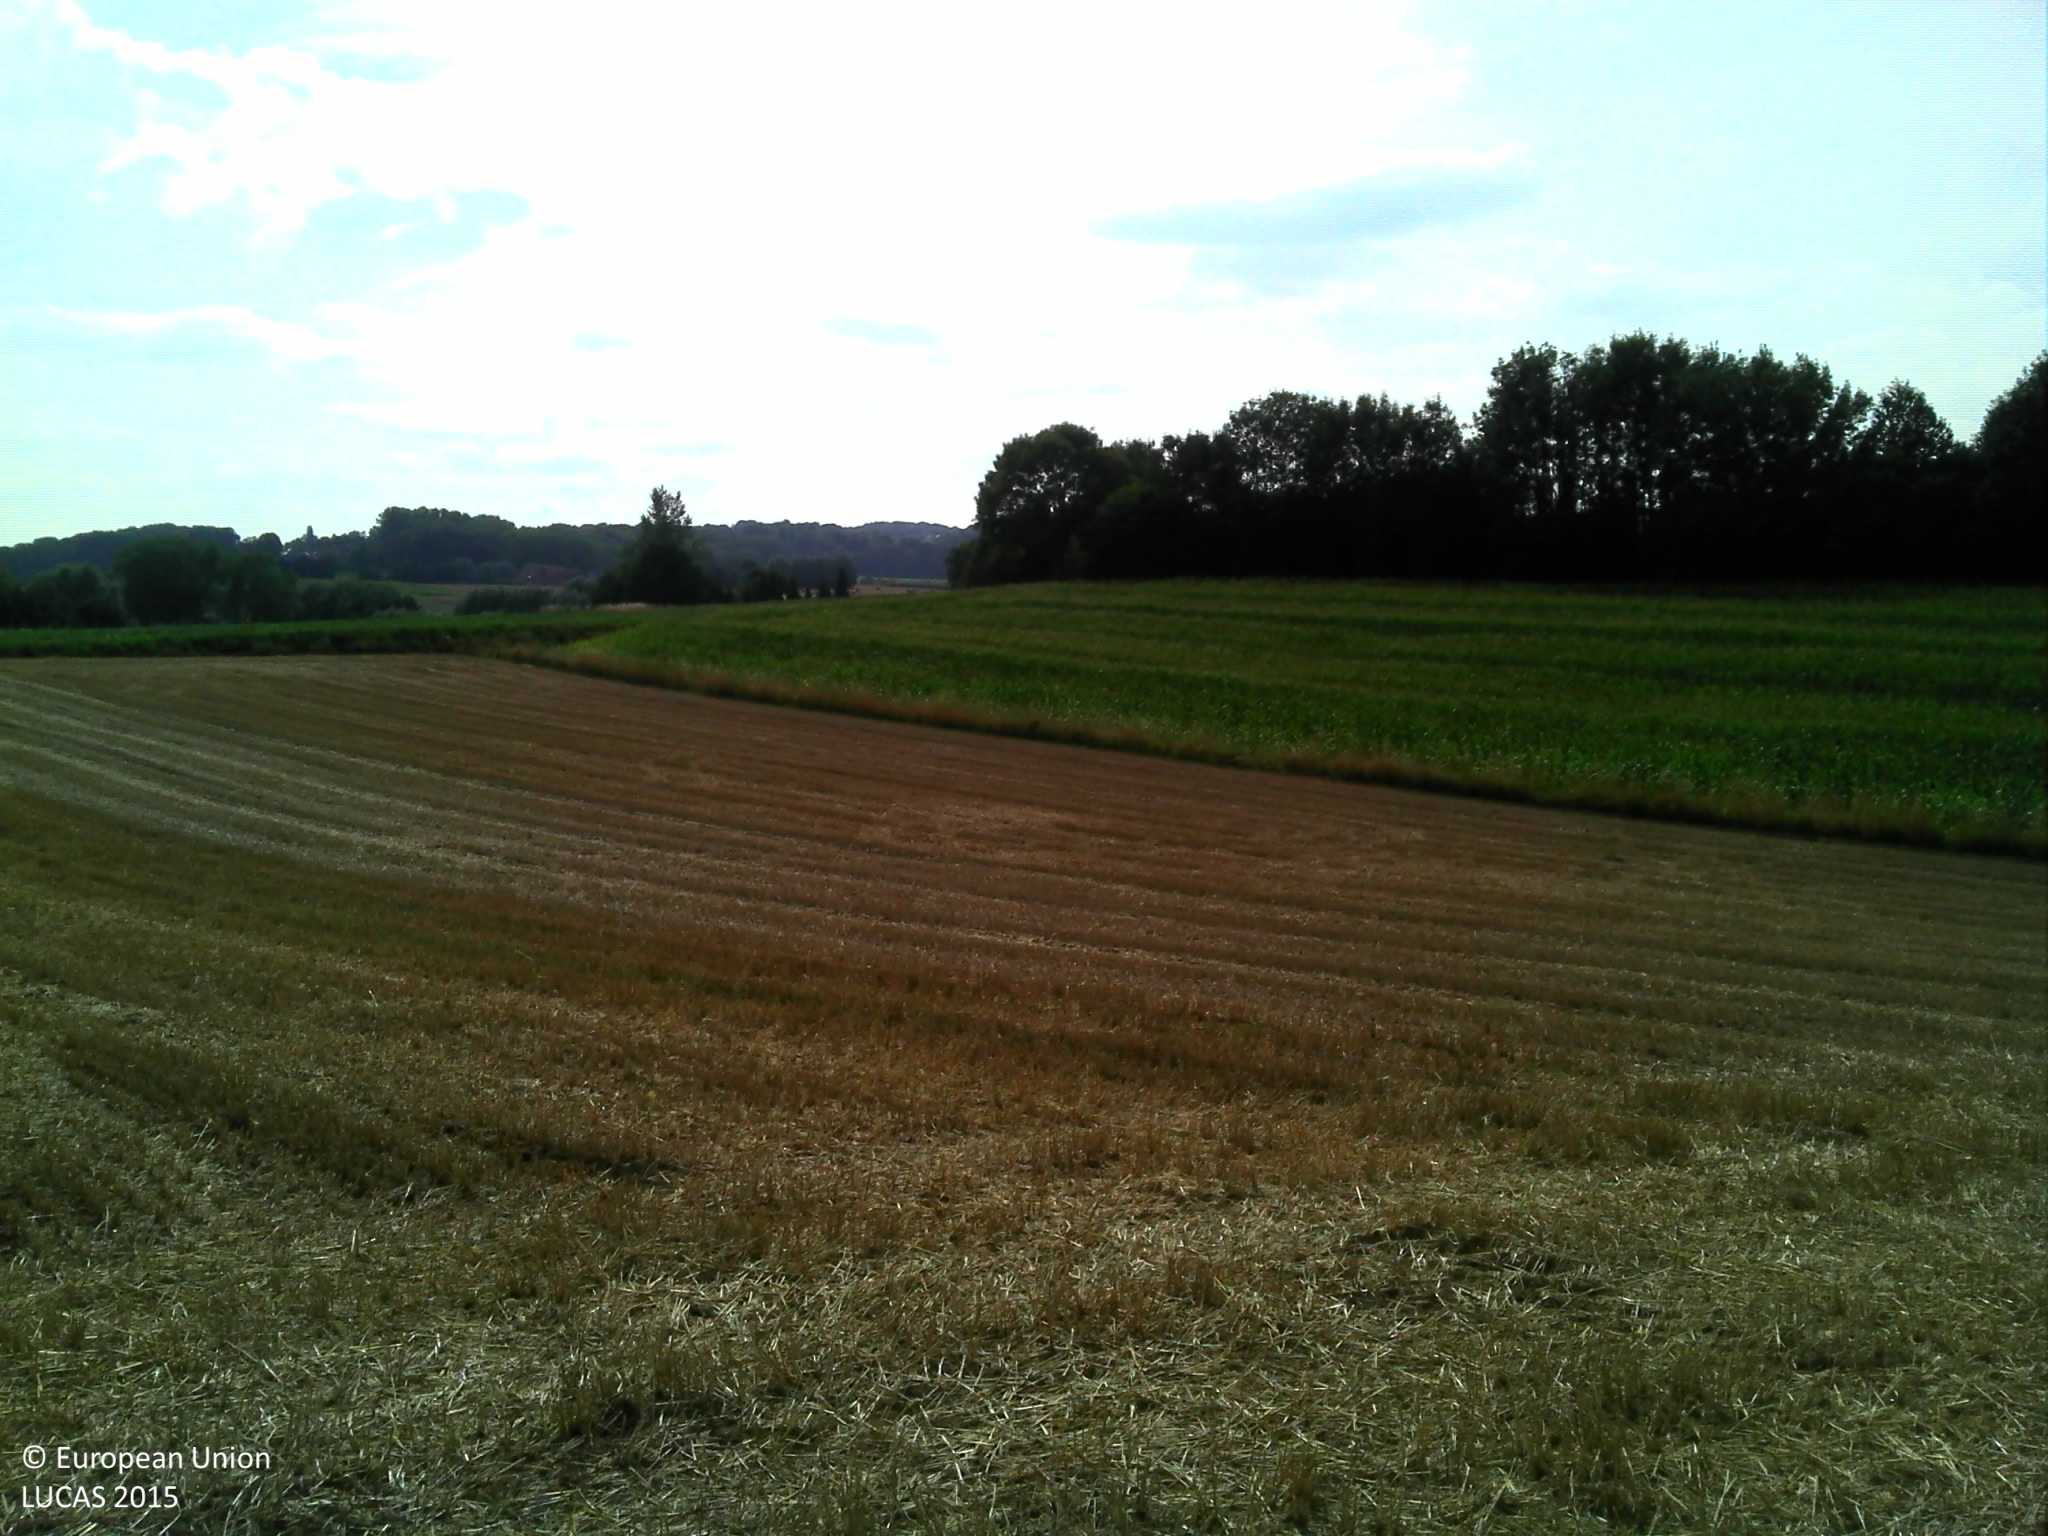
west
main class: Cropland
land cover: Common wheat
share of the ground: > 75 %
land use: Agriculture (excluding fallow land and kitchen gardens)
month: August
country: BE
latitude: 50.7129
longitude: 3.6908
